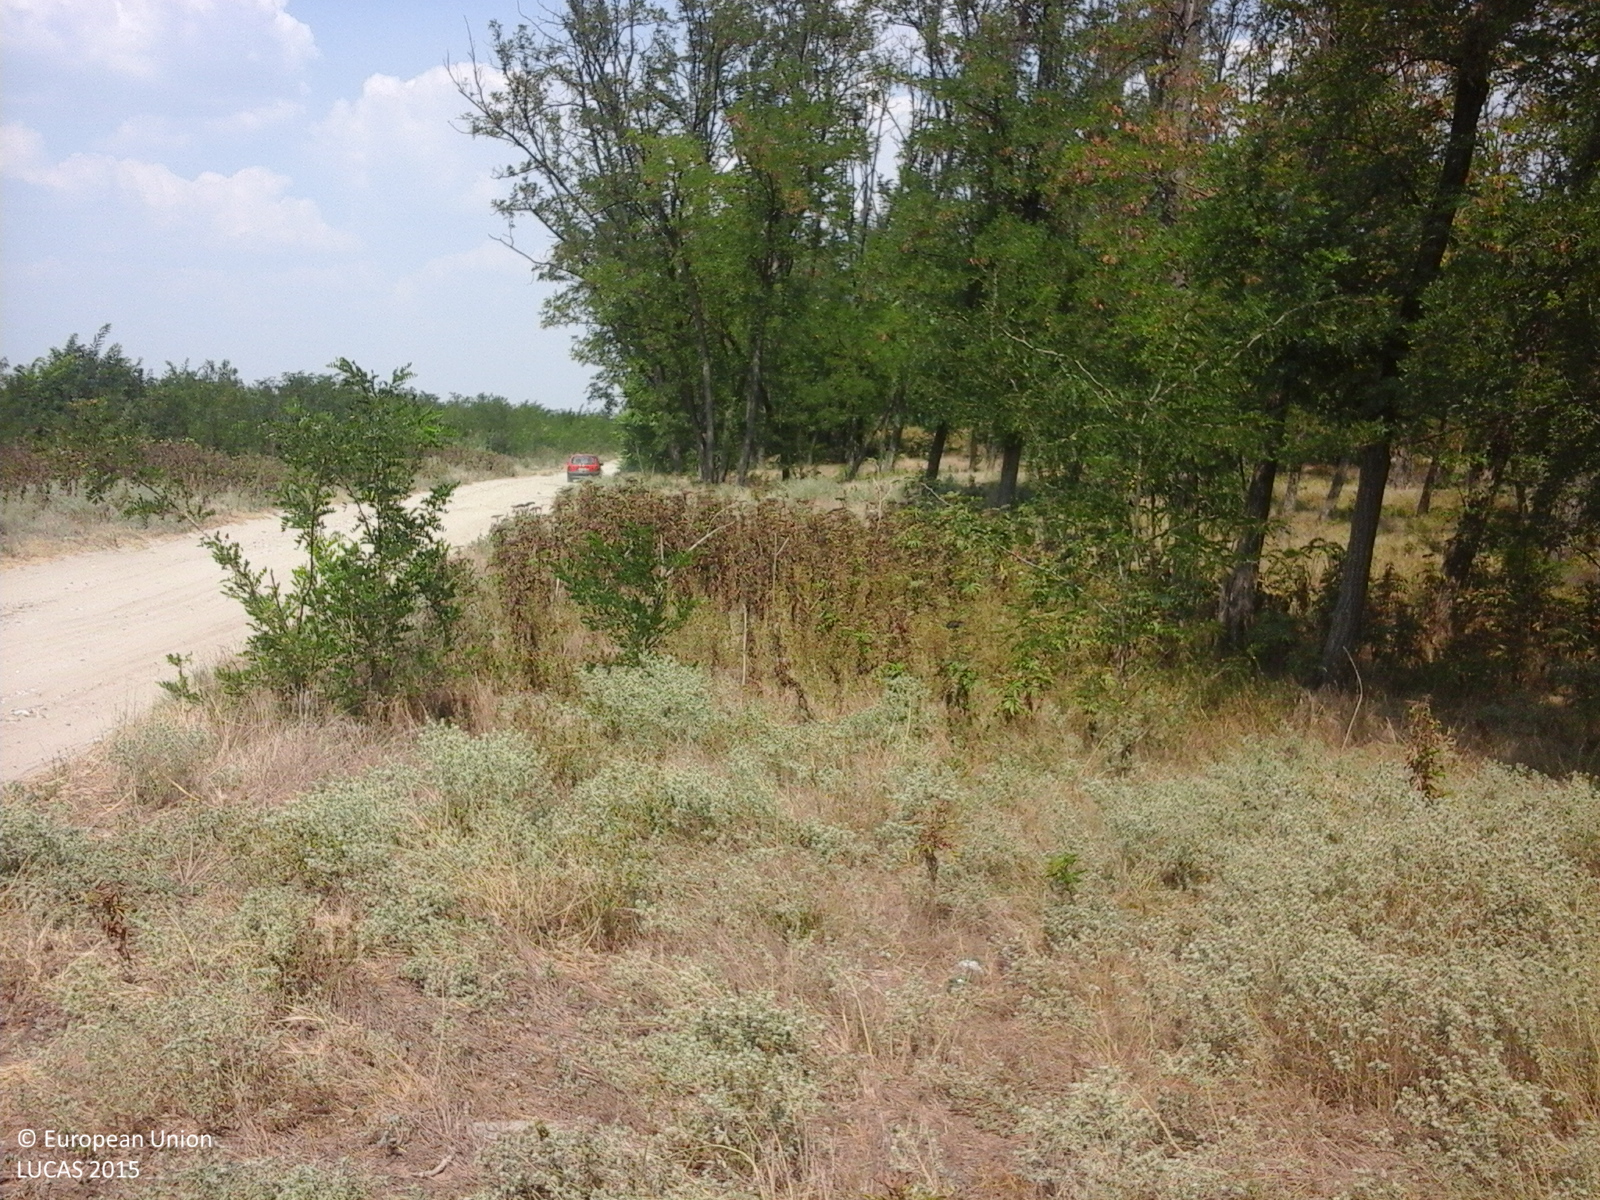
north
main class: Woodland
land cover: Broadleaved woodland
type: exotic forest
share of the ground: > 75 %
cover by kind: broadleaved forest trees 90 %, herbaceous plants 10 %
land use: Forestry
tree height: > 5 m
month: August
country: RO
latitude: 43.8751
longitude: 23.1469
